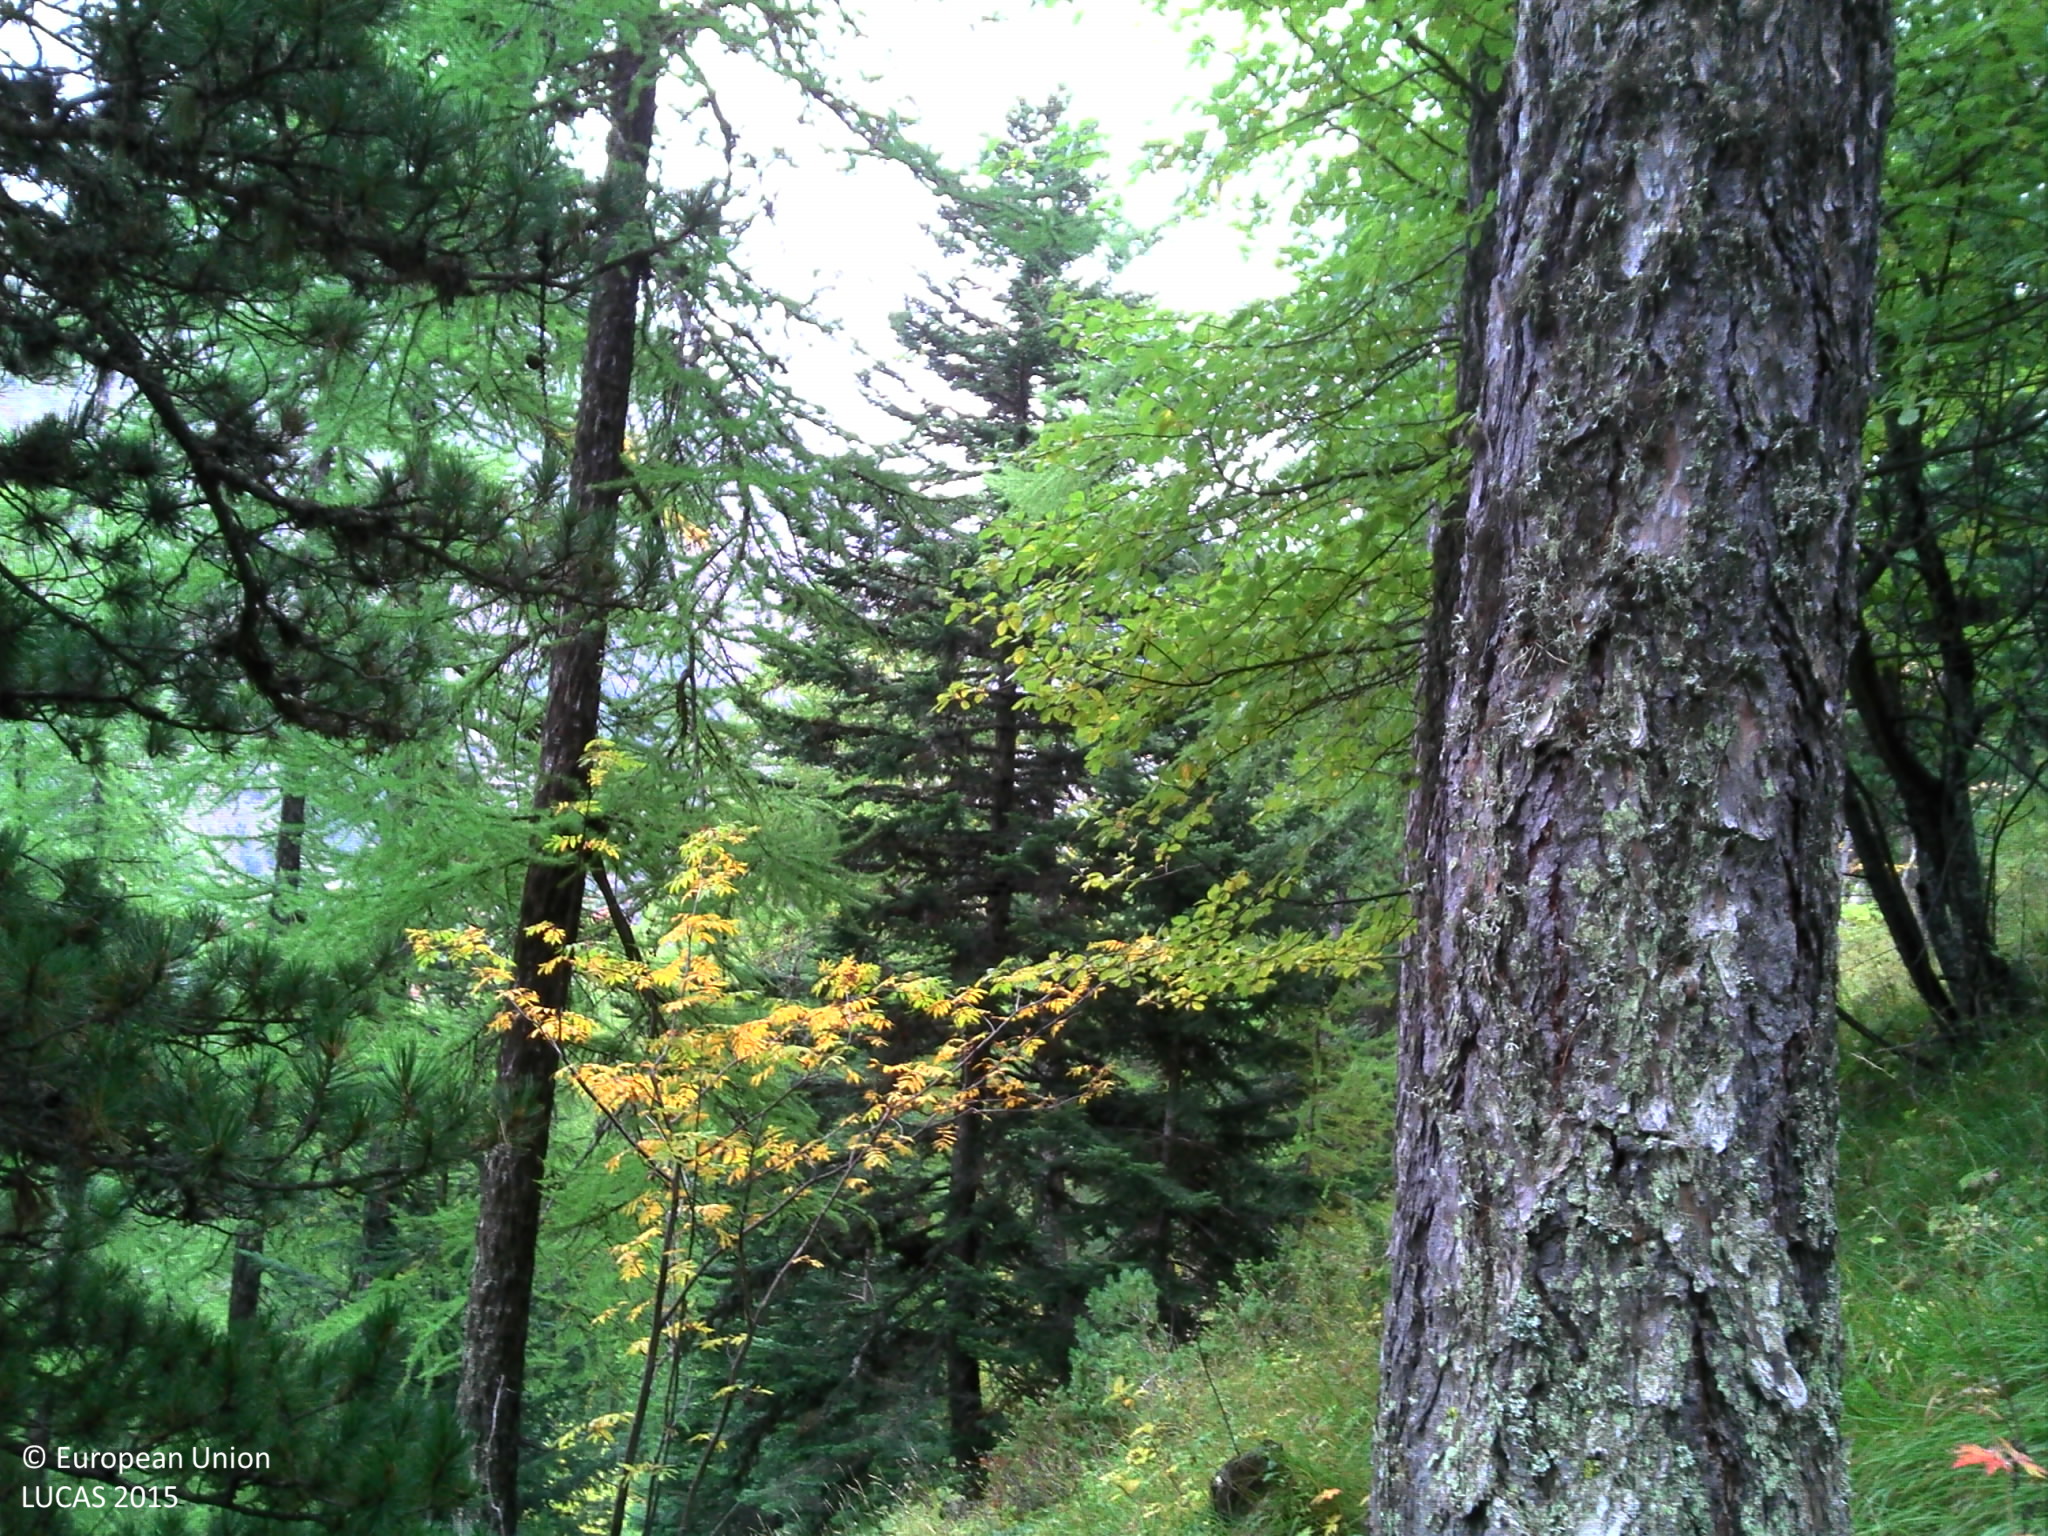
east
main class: Woodland
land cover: Other coniferous woodland
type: alpine coniferous forest
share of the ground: 50 - 75 %
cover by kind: coniferous forest trees 50 %, herbaceous plants 35 %, broadleaved forest trees 10 %, shrubs 5 %
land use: Forestry
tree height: > 5 m
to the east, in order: Other coniferous woodland; Grassland with sparse tree/shrub cover; Tracks; Ditches and canals; Tracks; Spruce dominated coniferous woodland; Tracks; Pine dominated mixed woodland
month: September
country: FR
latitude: 44.5466
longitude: 6.5700
